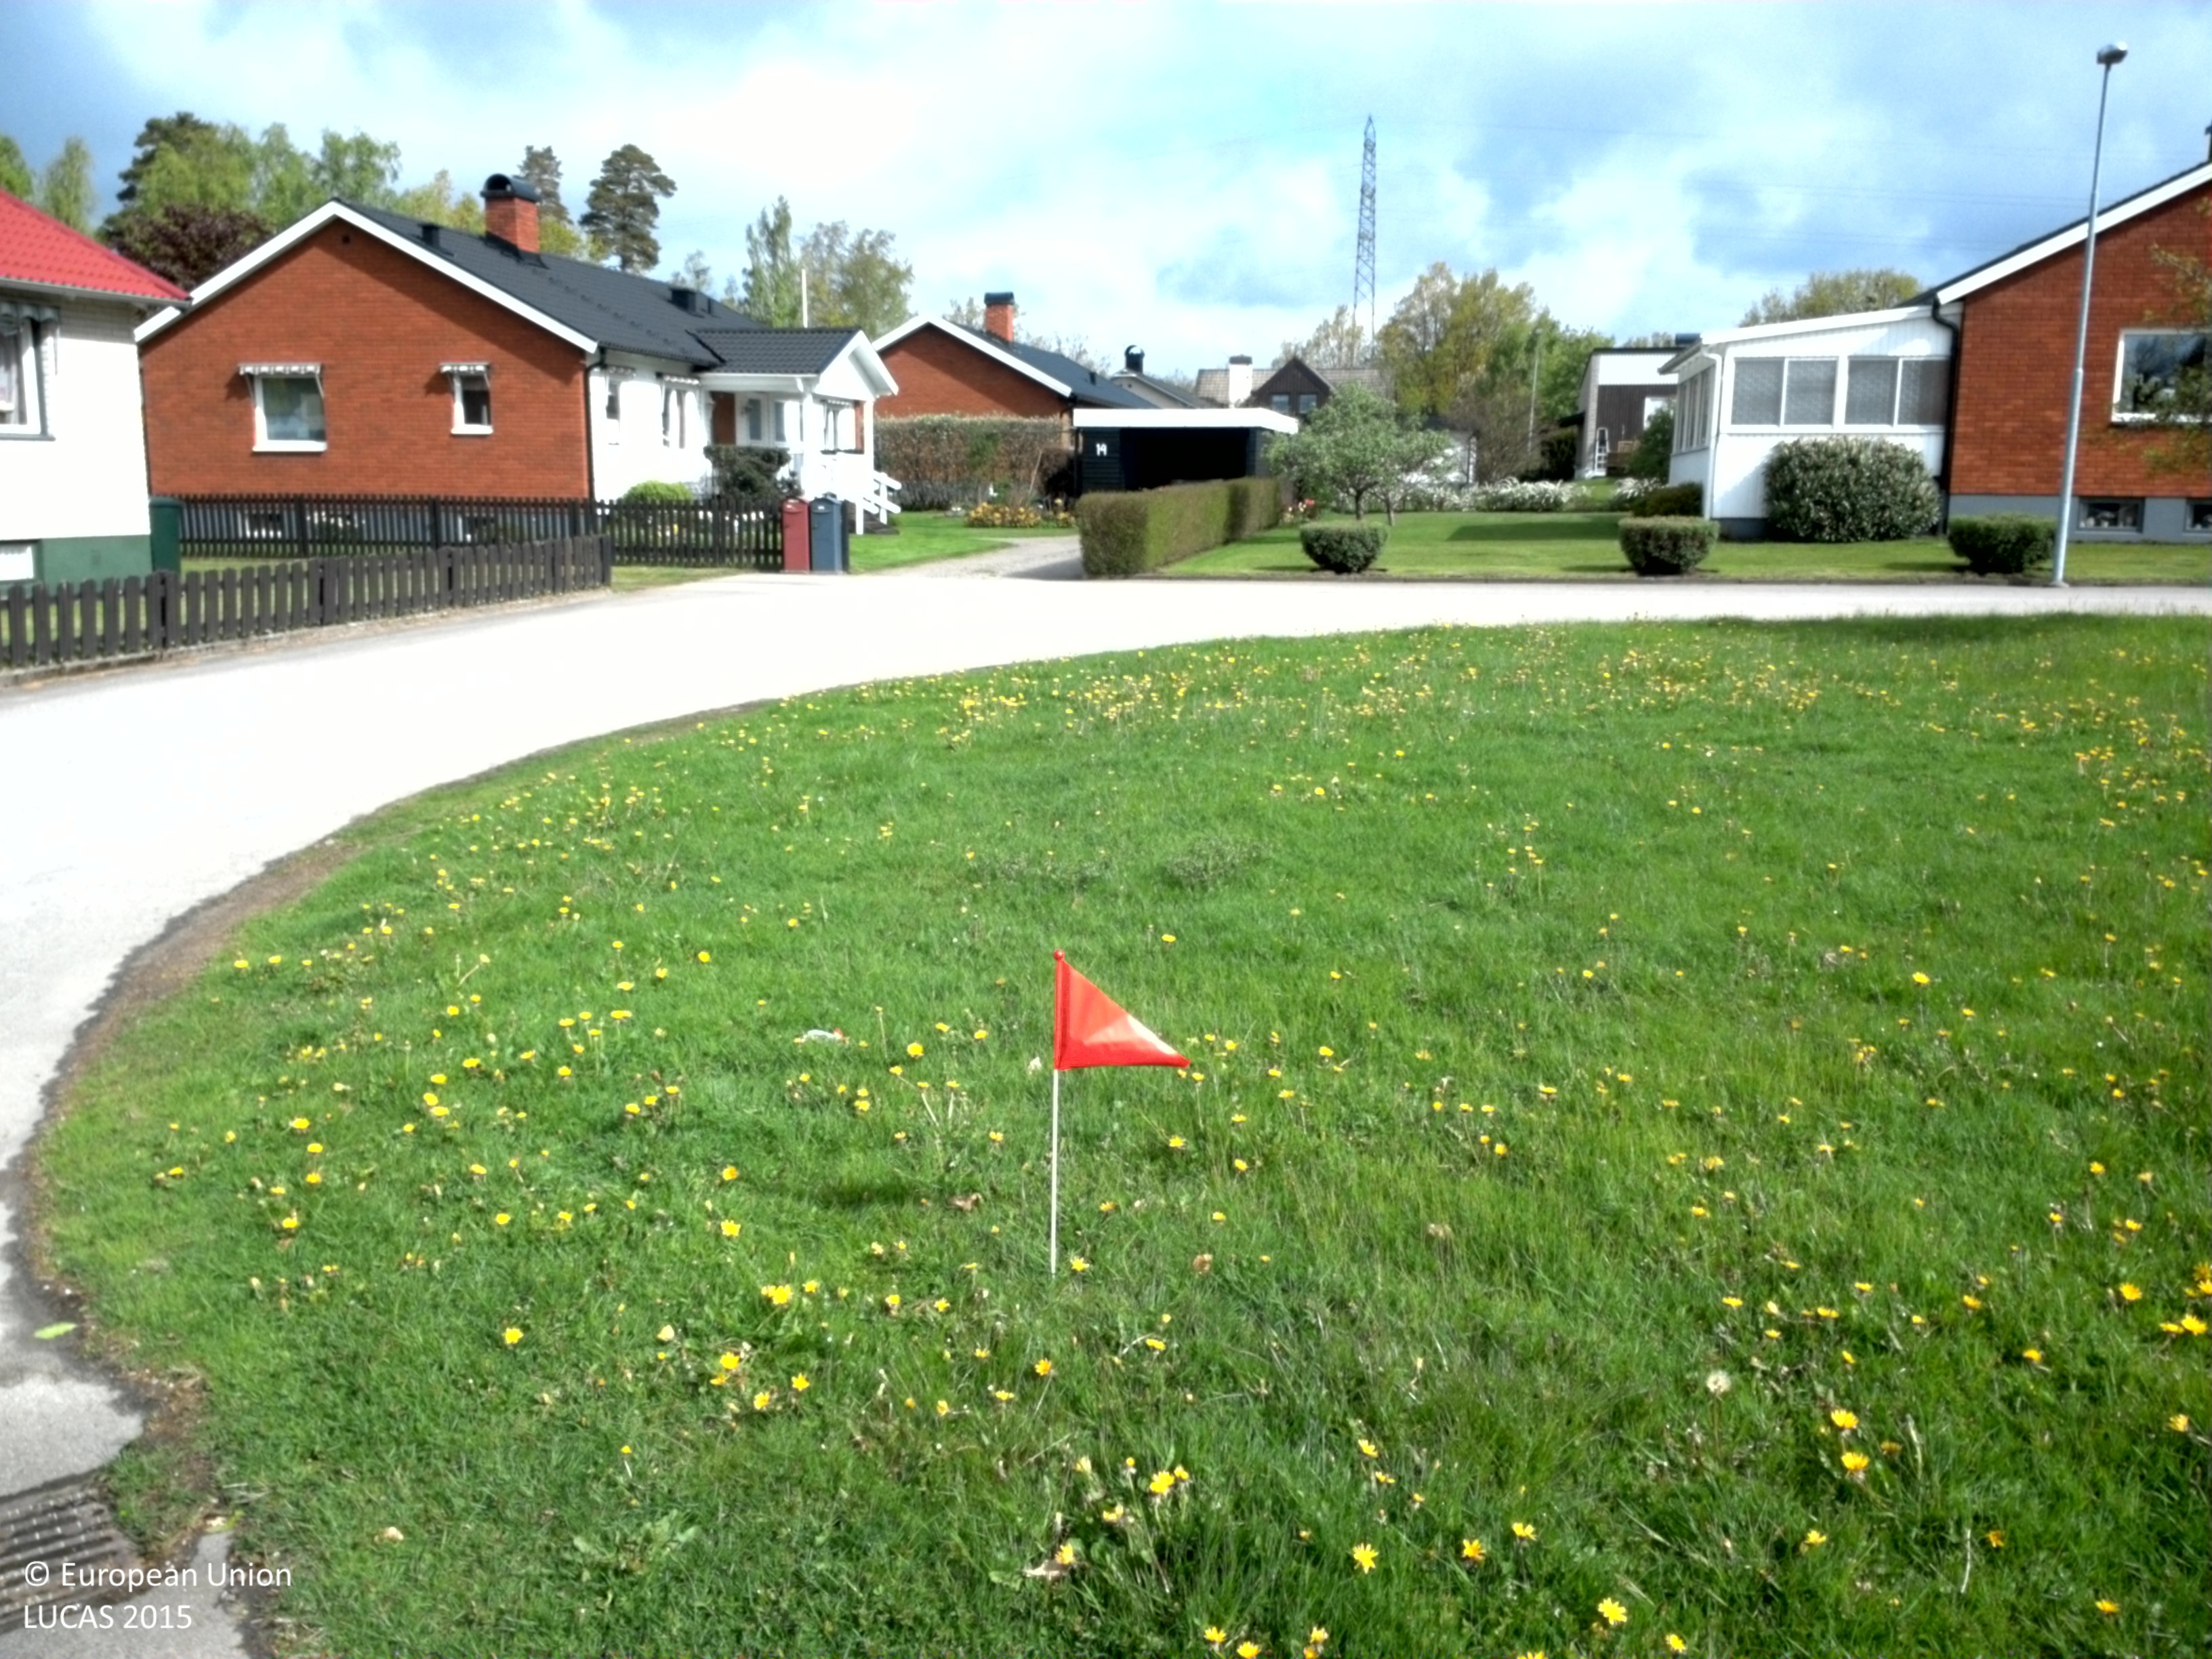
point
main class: Grassland
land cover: Grassland without tree/shrub cover
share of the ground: 50 - 75 %
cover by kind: herbaceous plants 50 %, consolidated bare surface 25 %
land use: Community services
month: May
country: SE
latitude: 56.8748
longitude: 14.7389
